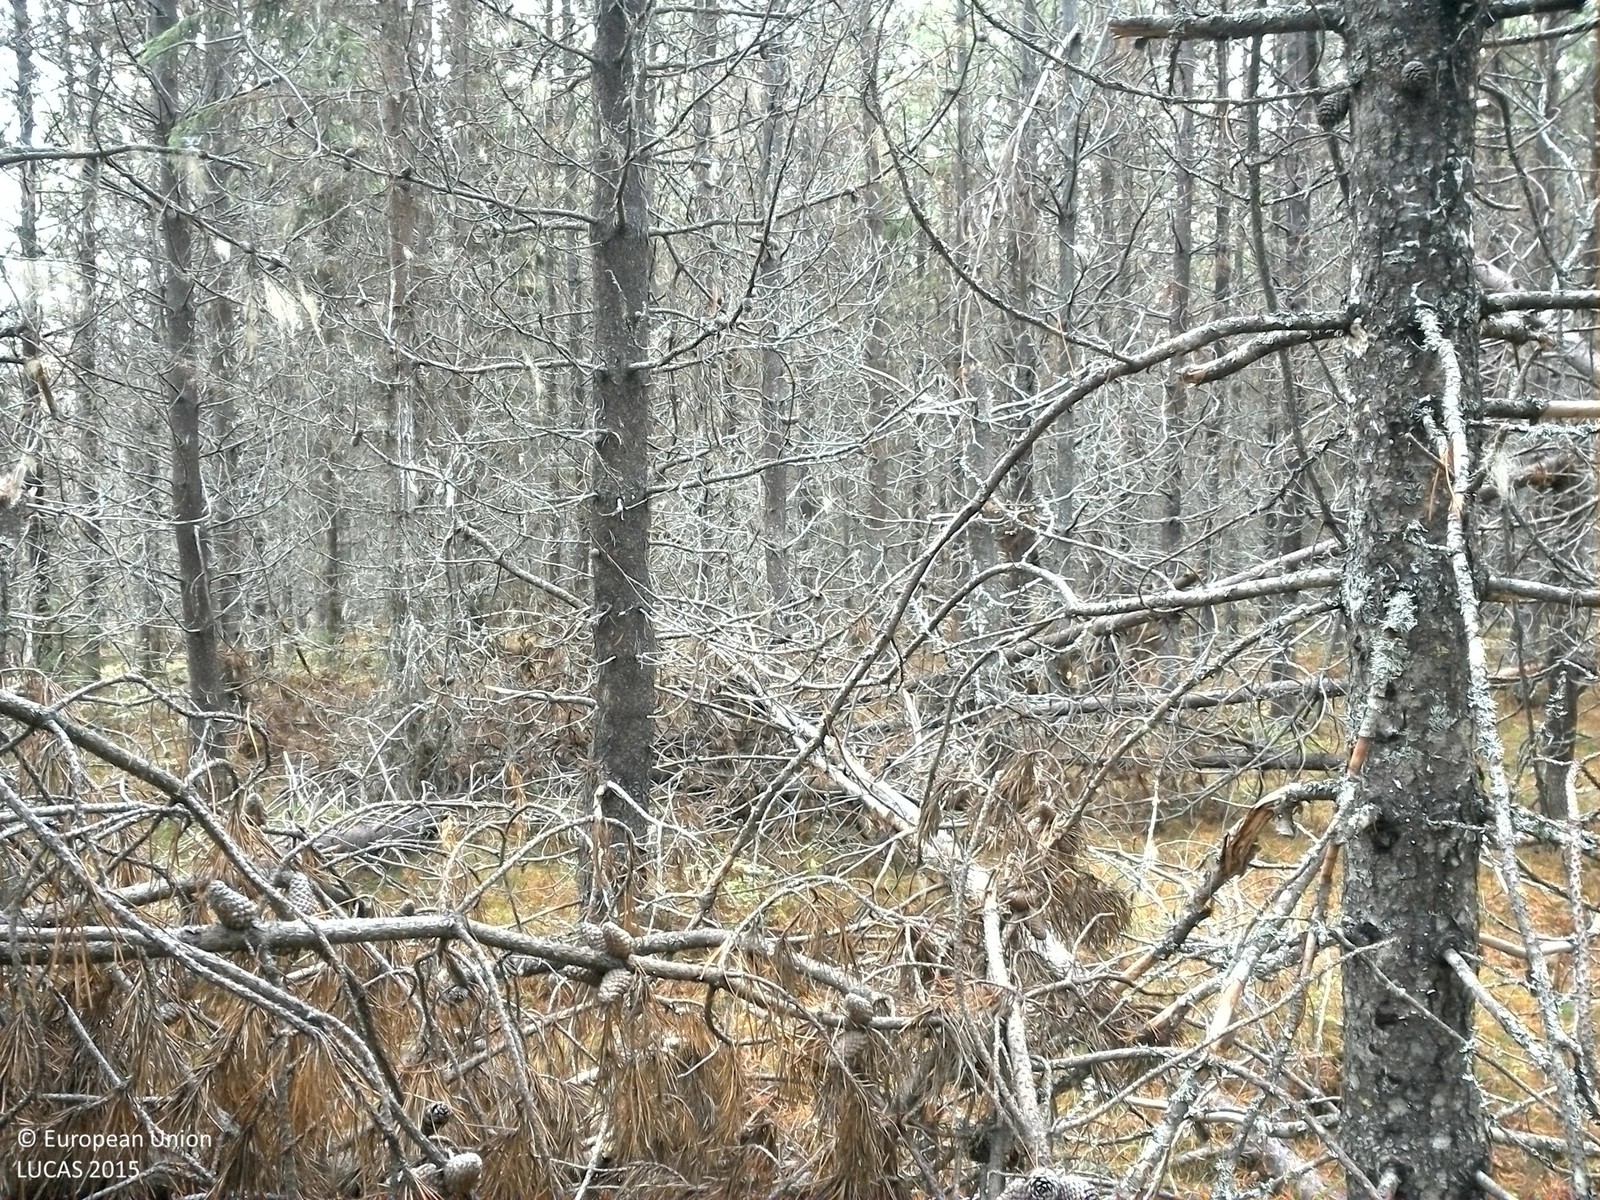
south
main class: Woodland
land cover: Pine dominated coniferous woodland
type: exotic forest
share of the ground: 50 - 75 %
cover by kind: coniferous forest trees 60 %, lichens and mosses 20 %, shrubs 10 %, herbaceous plants 10 %
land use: Forestry
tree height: > 5 m
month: October
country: SE
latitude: 64.1057
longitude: 15.9434
